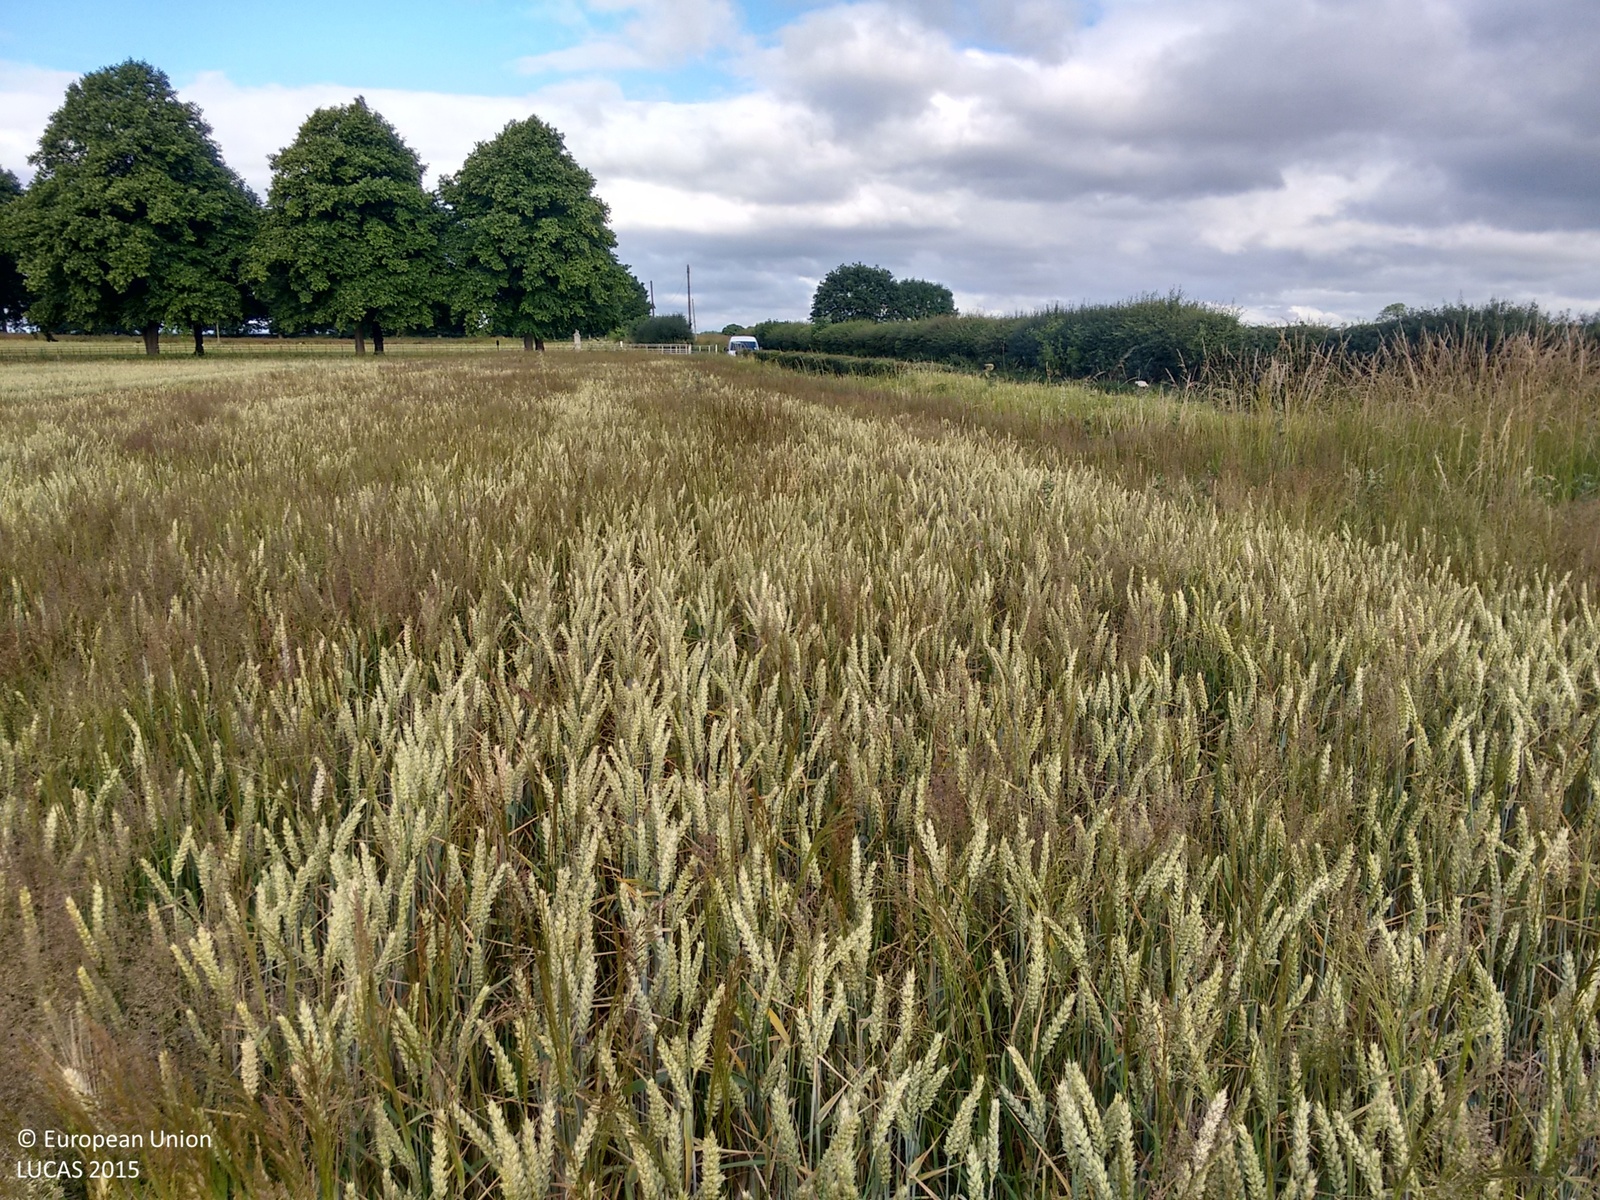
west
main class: Cropland
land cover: Common wheat
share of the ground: > 75 %
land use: Agriculture (excluding fallow land and kitchen gardens)
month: July
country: GB
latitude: 53.3915
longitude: -0.9751
